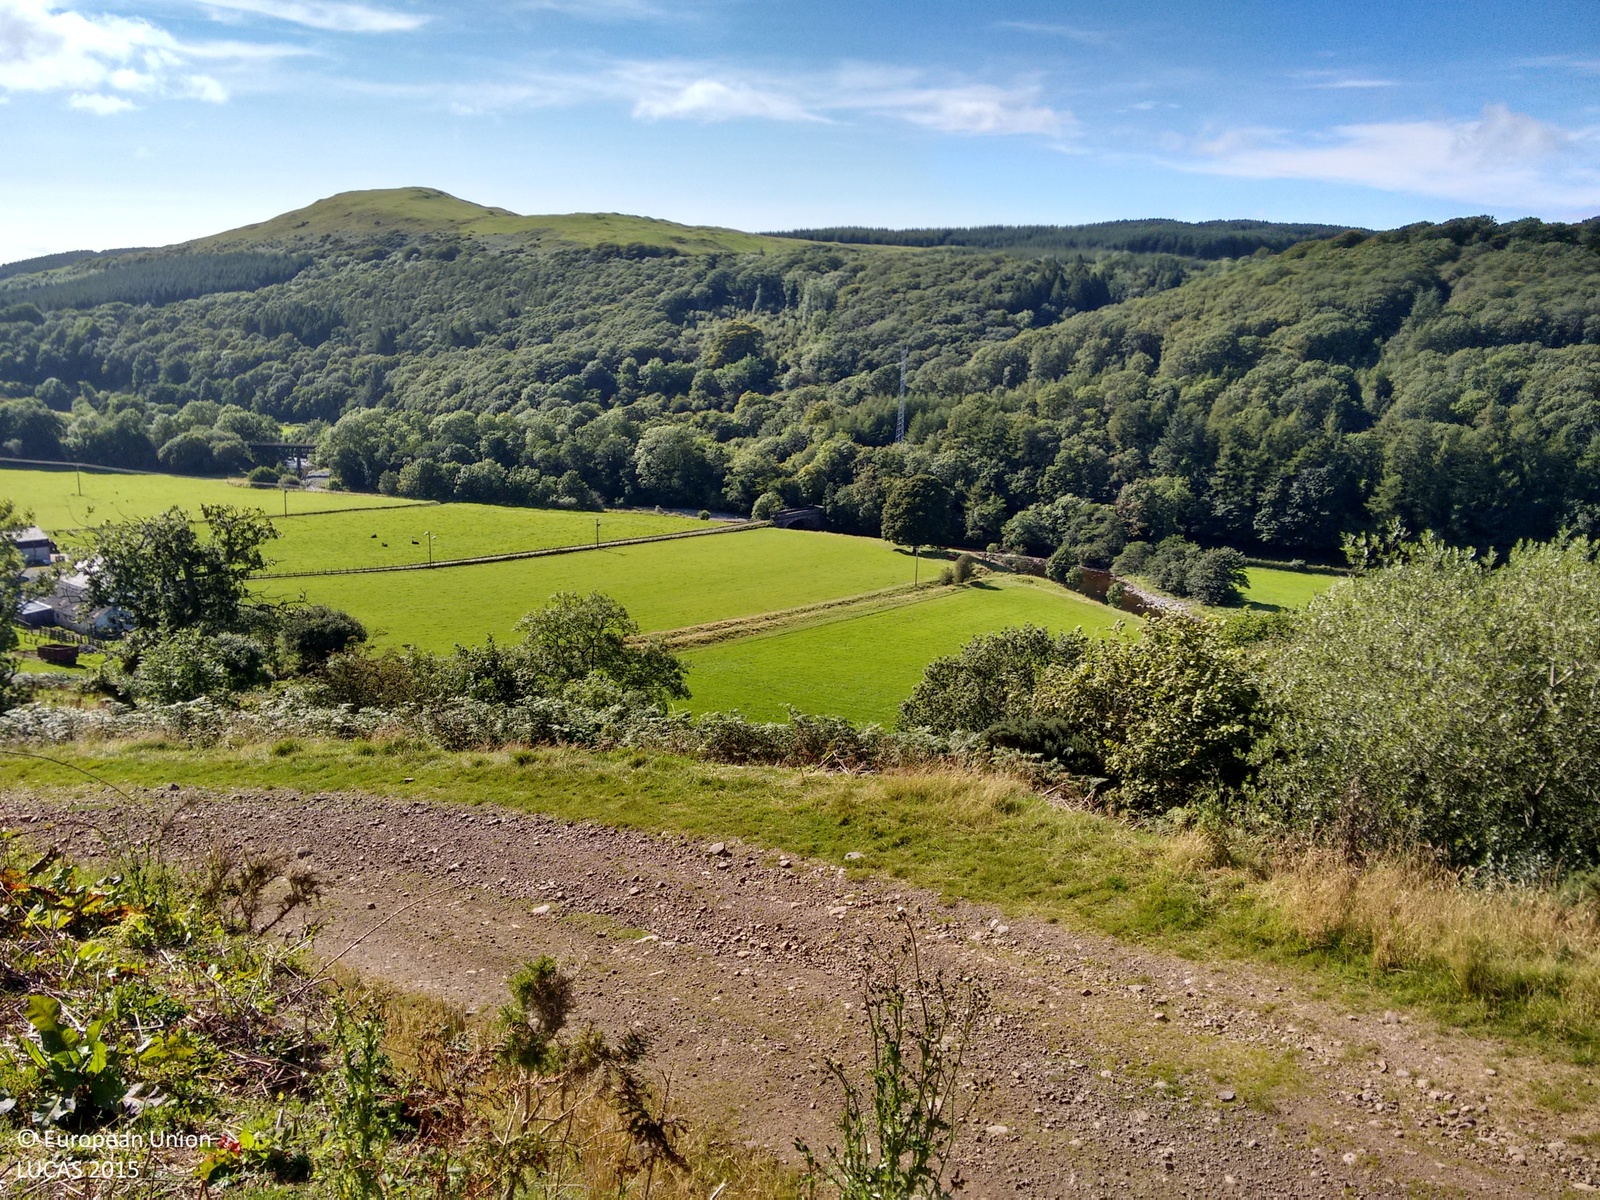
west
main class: Grassland
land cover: Grassland without tree/shrub cover
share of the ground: > 75 %
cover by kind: herbaceous plants 100 %
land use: Agriculture (excluding fallow land and kitchen gardens)
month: September
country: GB
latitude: 55.1562
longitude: -4.8139
